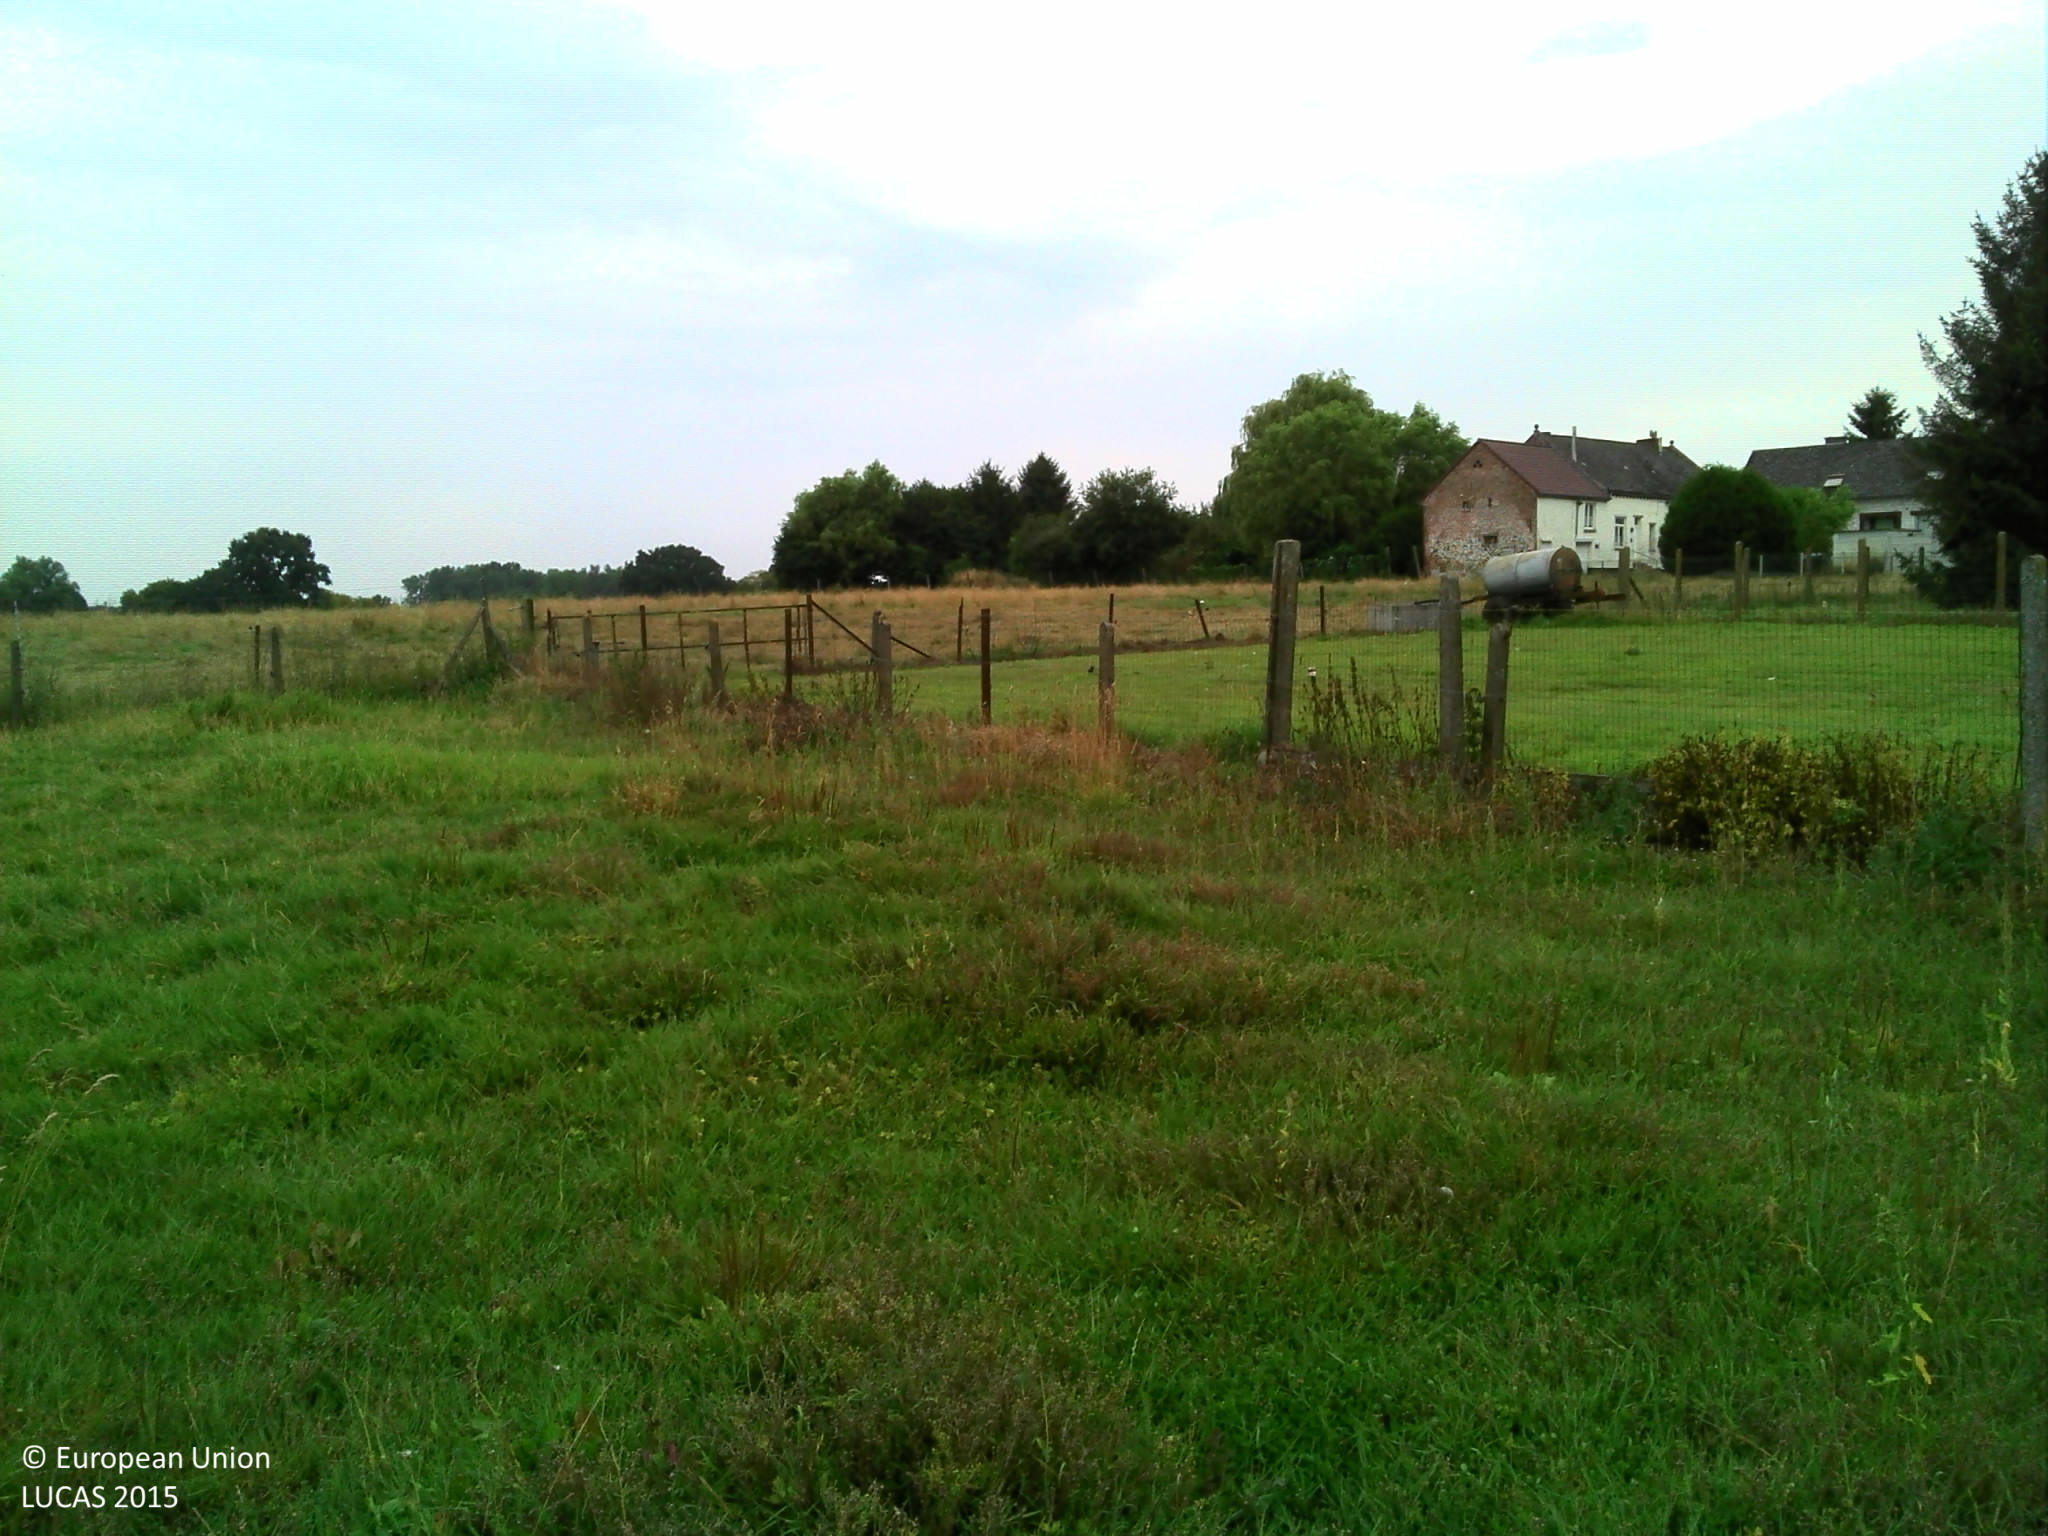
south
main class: Grassland
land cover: Grassland without tree/shrub cover
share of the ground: > 75 %
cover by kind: herbaceous plants 100 %
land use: Agriculture (excluding fallow land and kitchen gardens)
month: August
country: BE
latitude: 50.6863
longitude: 3.8649
